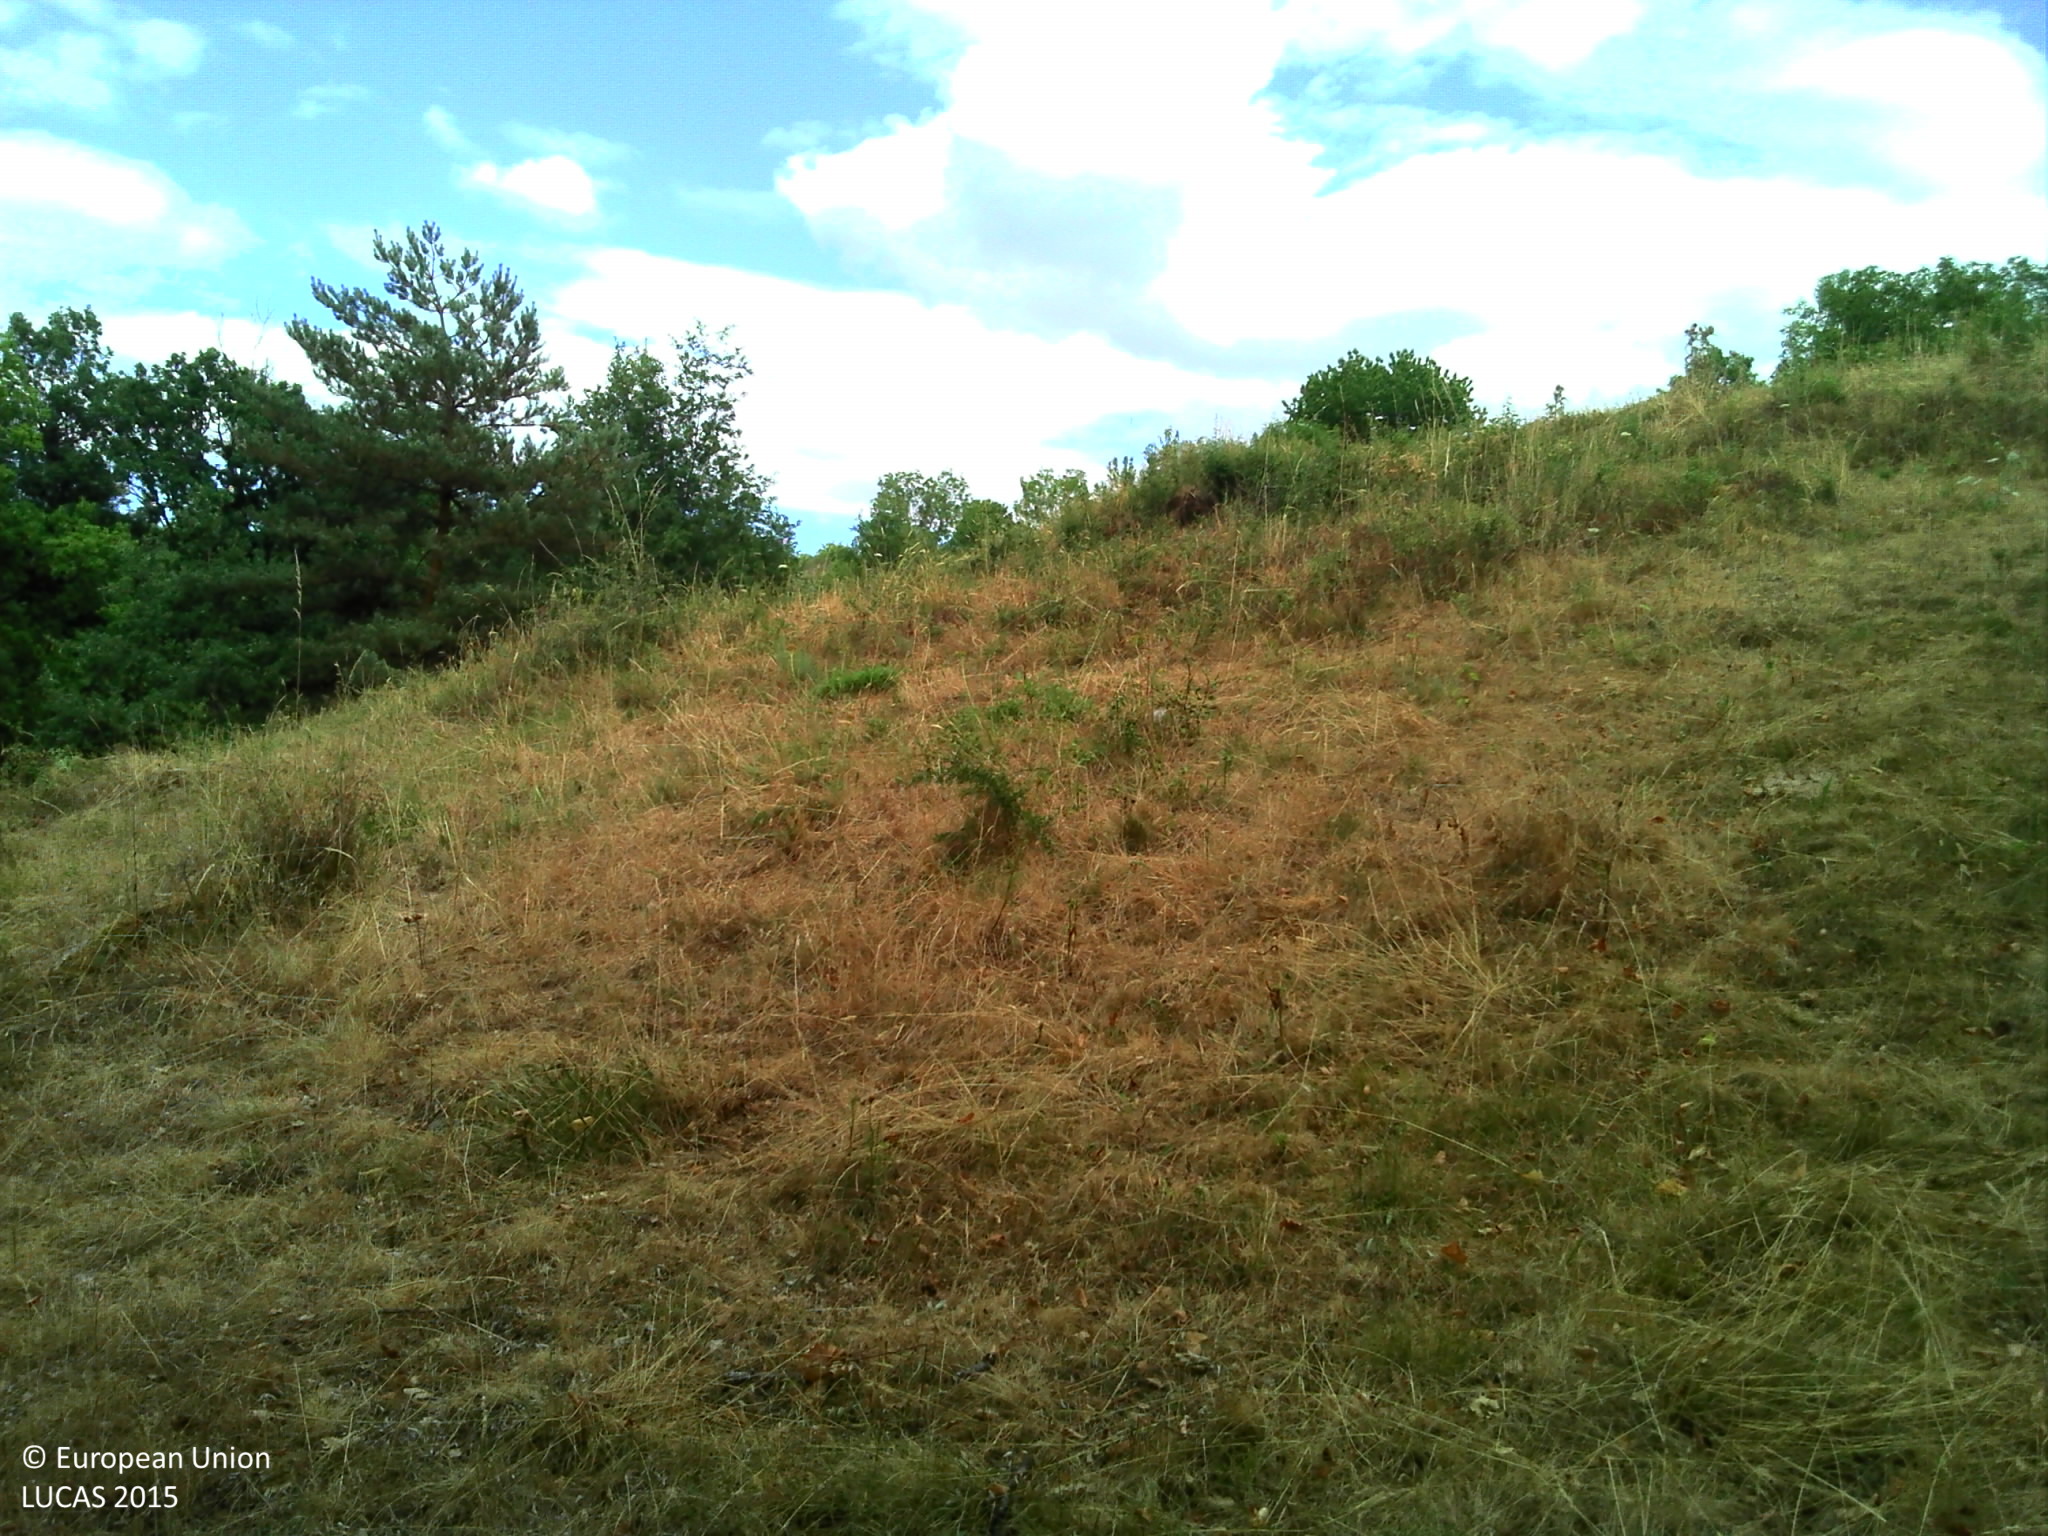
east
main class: Woodland
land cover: Broadleaved woodland
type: acidophilous oak and oak-birch forest
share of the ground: > 75 %
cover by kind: broadleaved forest trees 75 %, herbaceous plants 15 %, shrubs 10 %
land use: Forestry
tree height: > 5 m
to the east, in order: Broadleaved woodland; Fences; Grassland without tree/shrub cover; Broadleaved woodland; Grassland without tree/shrub cover; Abandoned hedges; Dry stone walls; Grassland without tree/shrub cover; Electric lines; Fences; Grassland without tree/shrub cover; Tracks
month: July
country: FR
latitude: 45.1353
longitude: 3.4033
